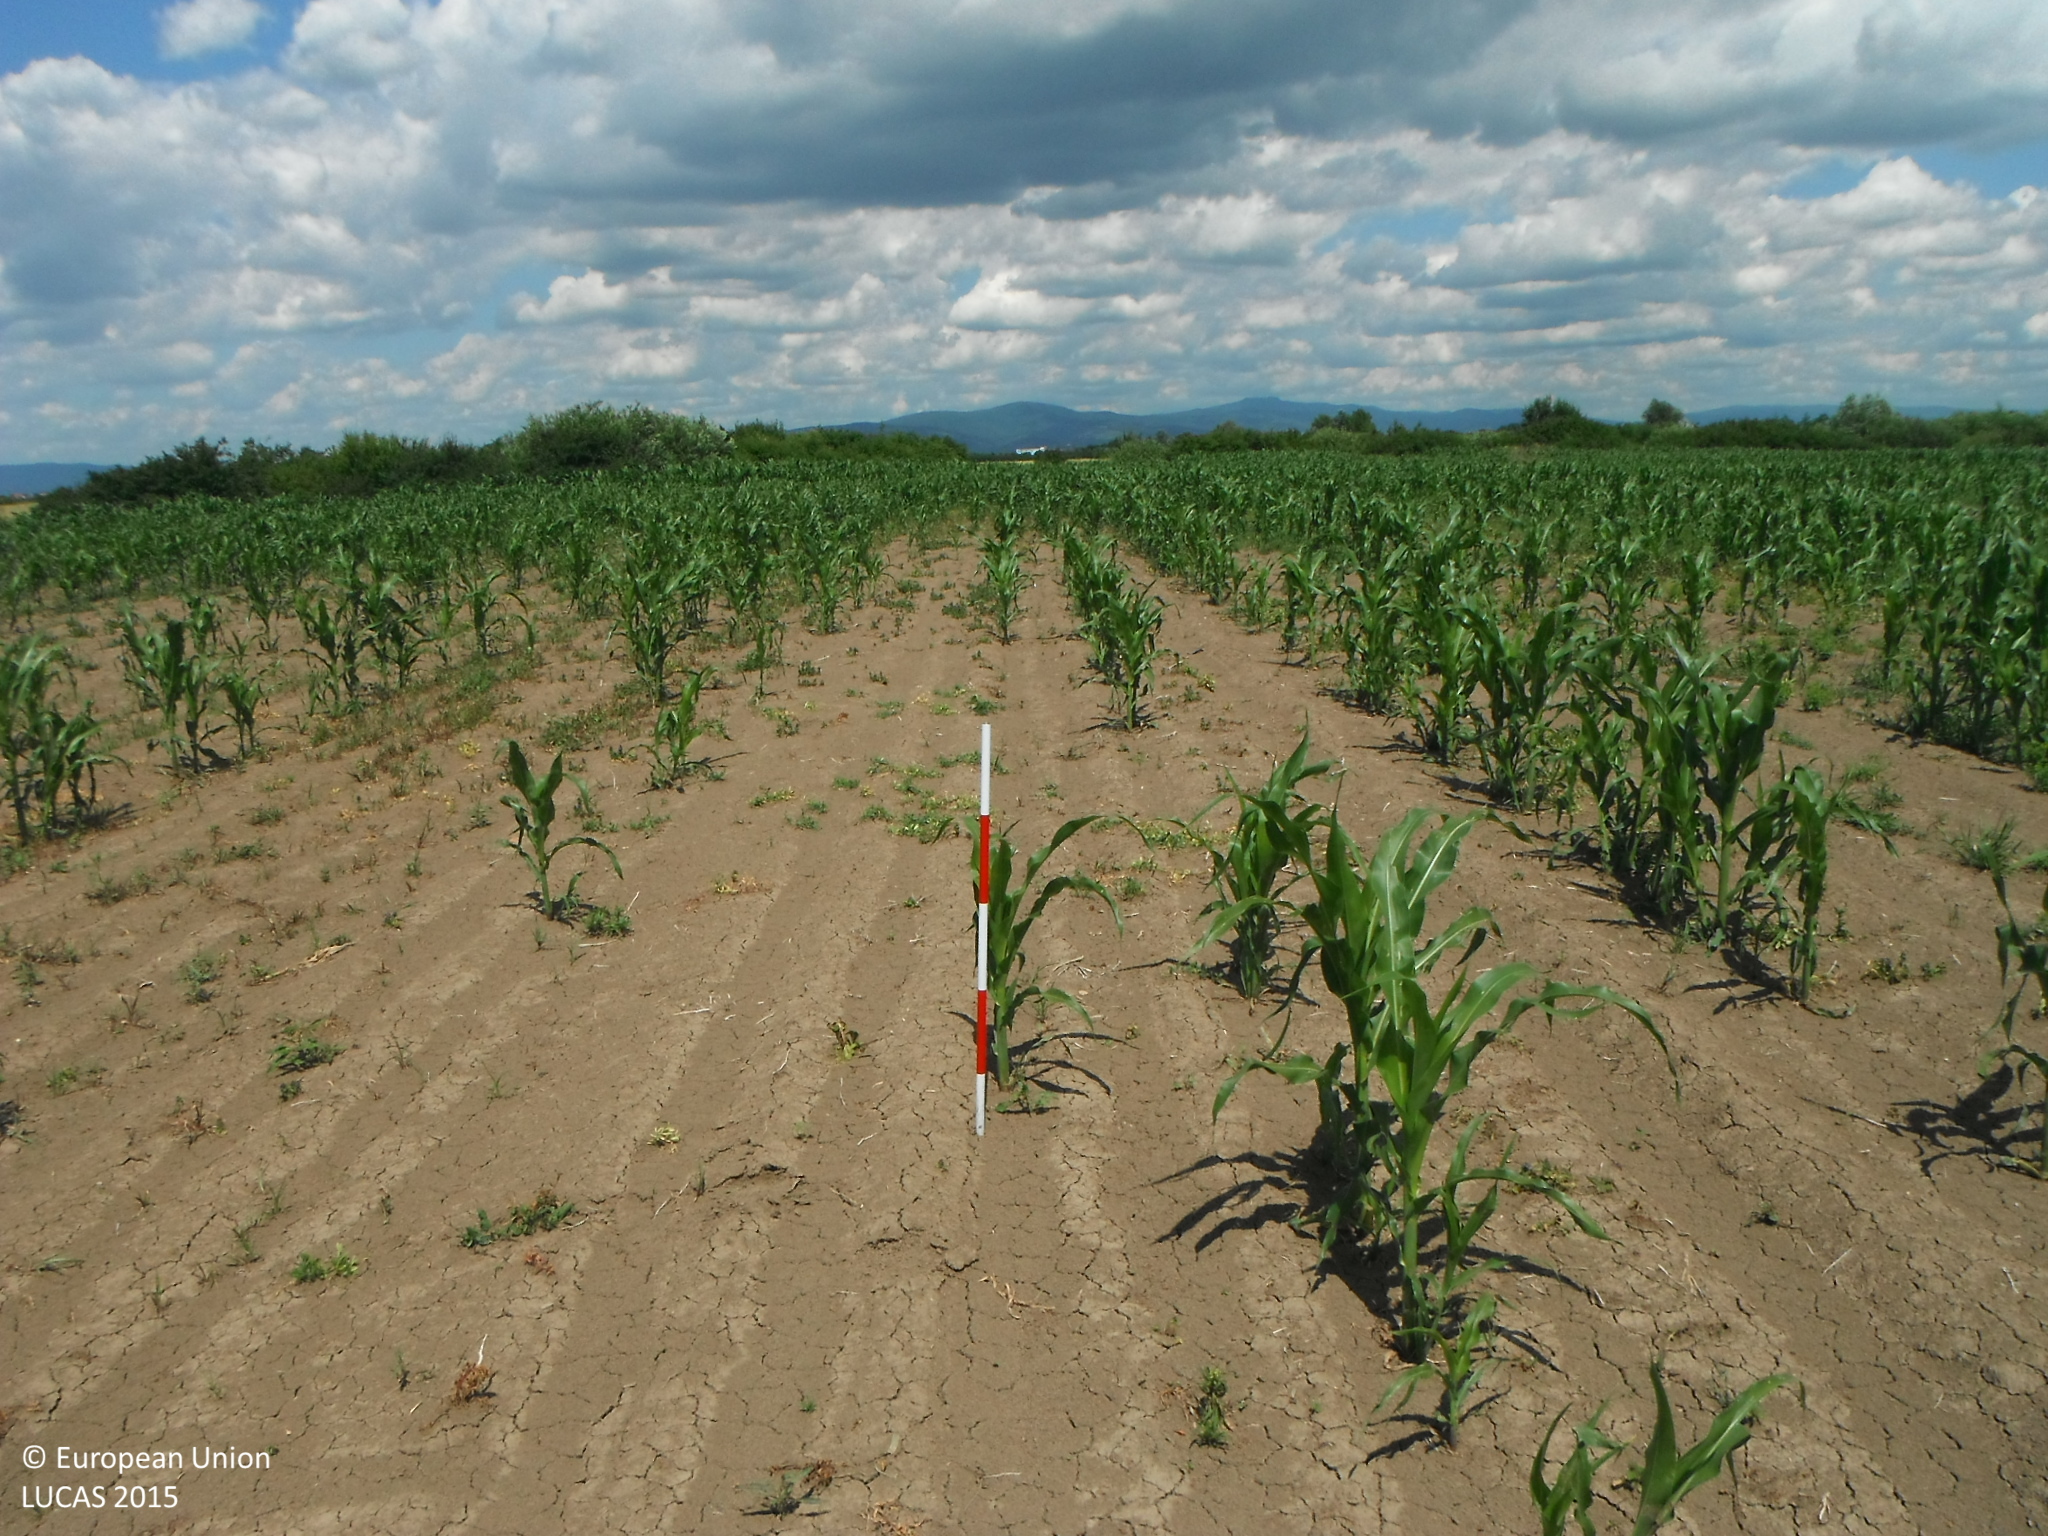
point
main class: Cropland
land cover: Maize
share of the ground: < 10 %
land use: Agriculture (excluding fallow land and kitchen gardens)
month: June
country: SK
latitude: 48.7079
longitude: 21.8619
